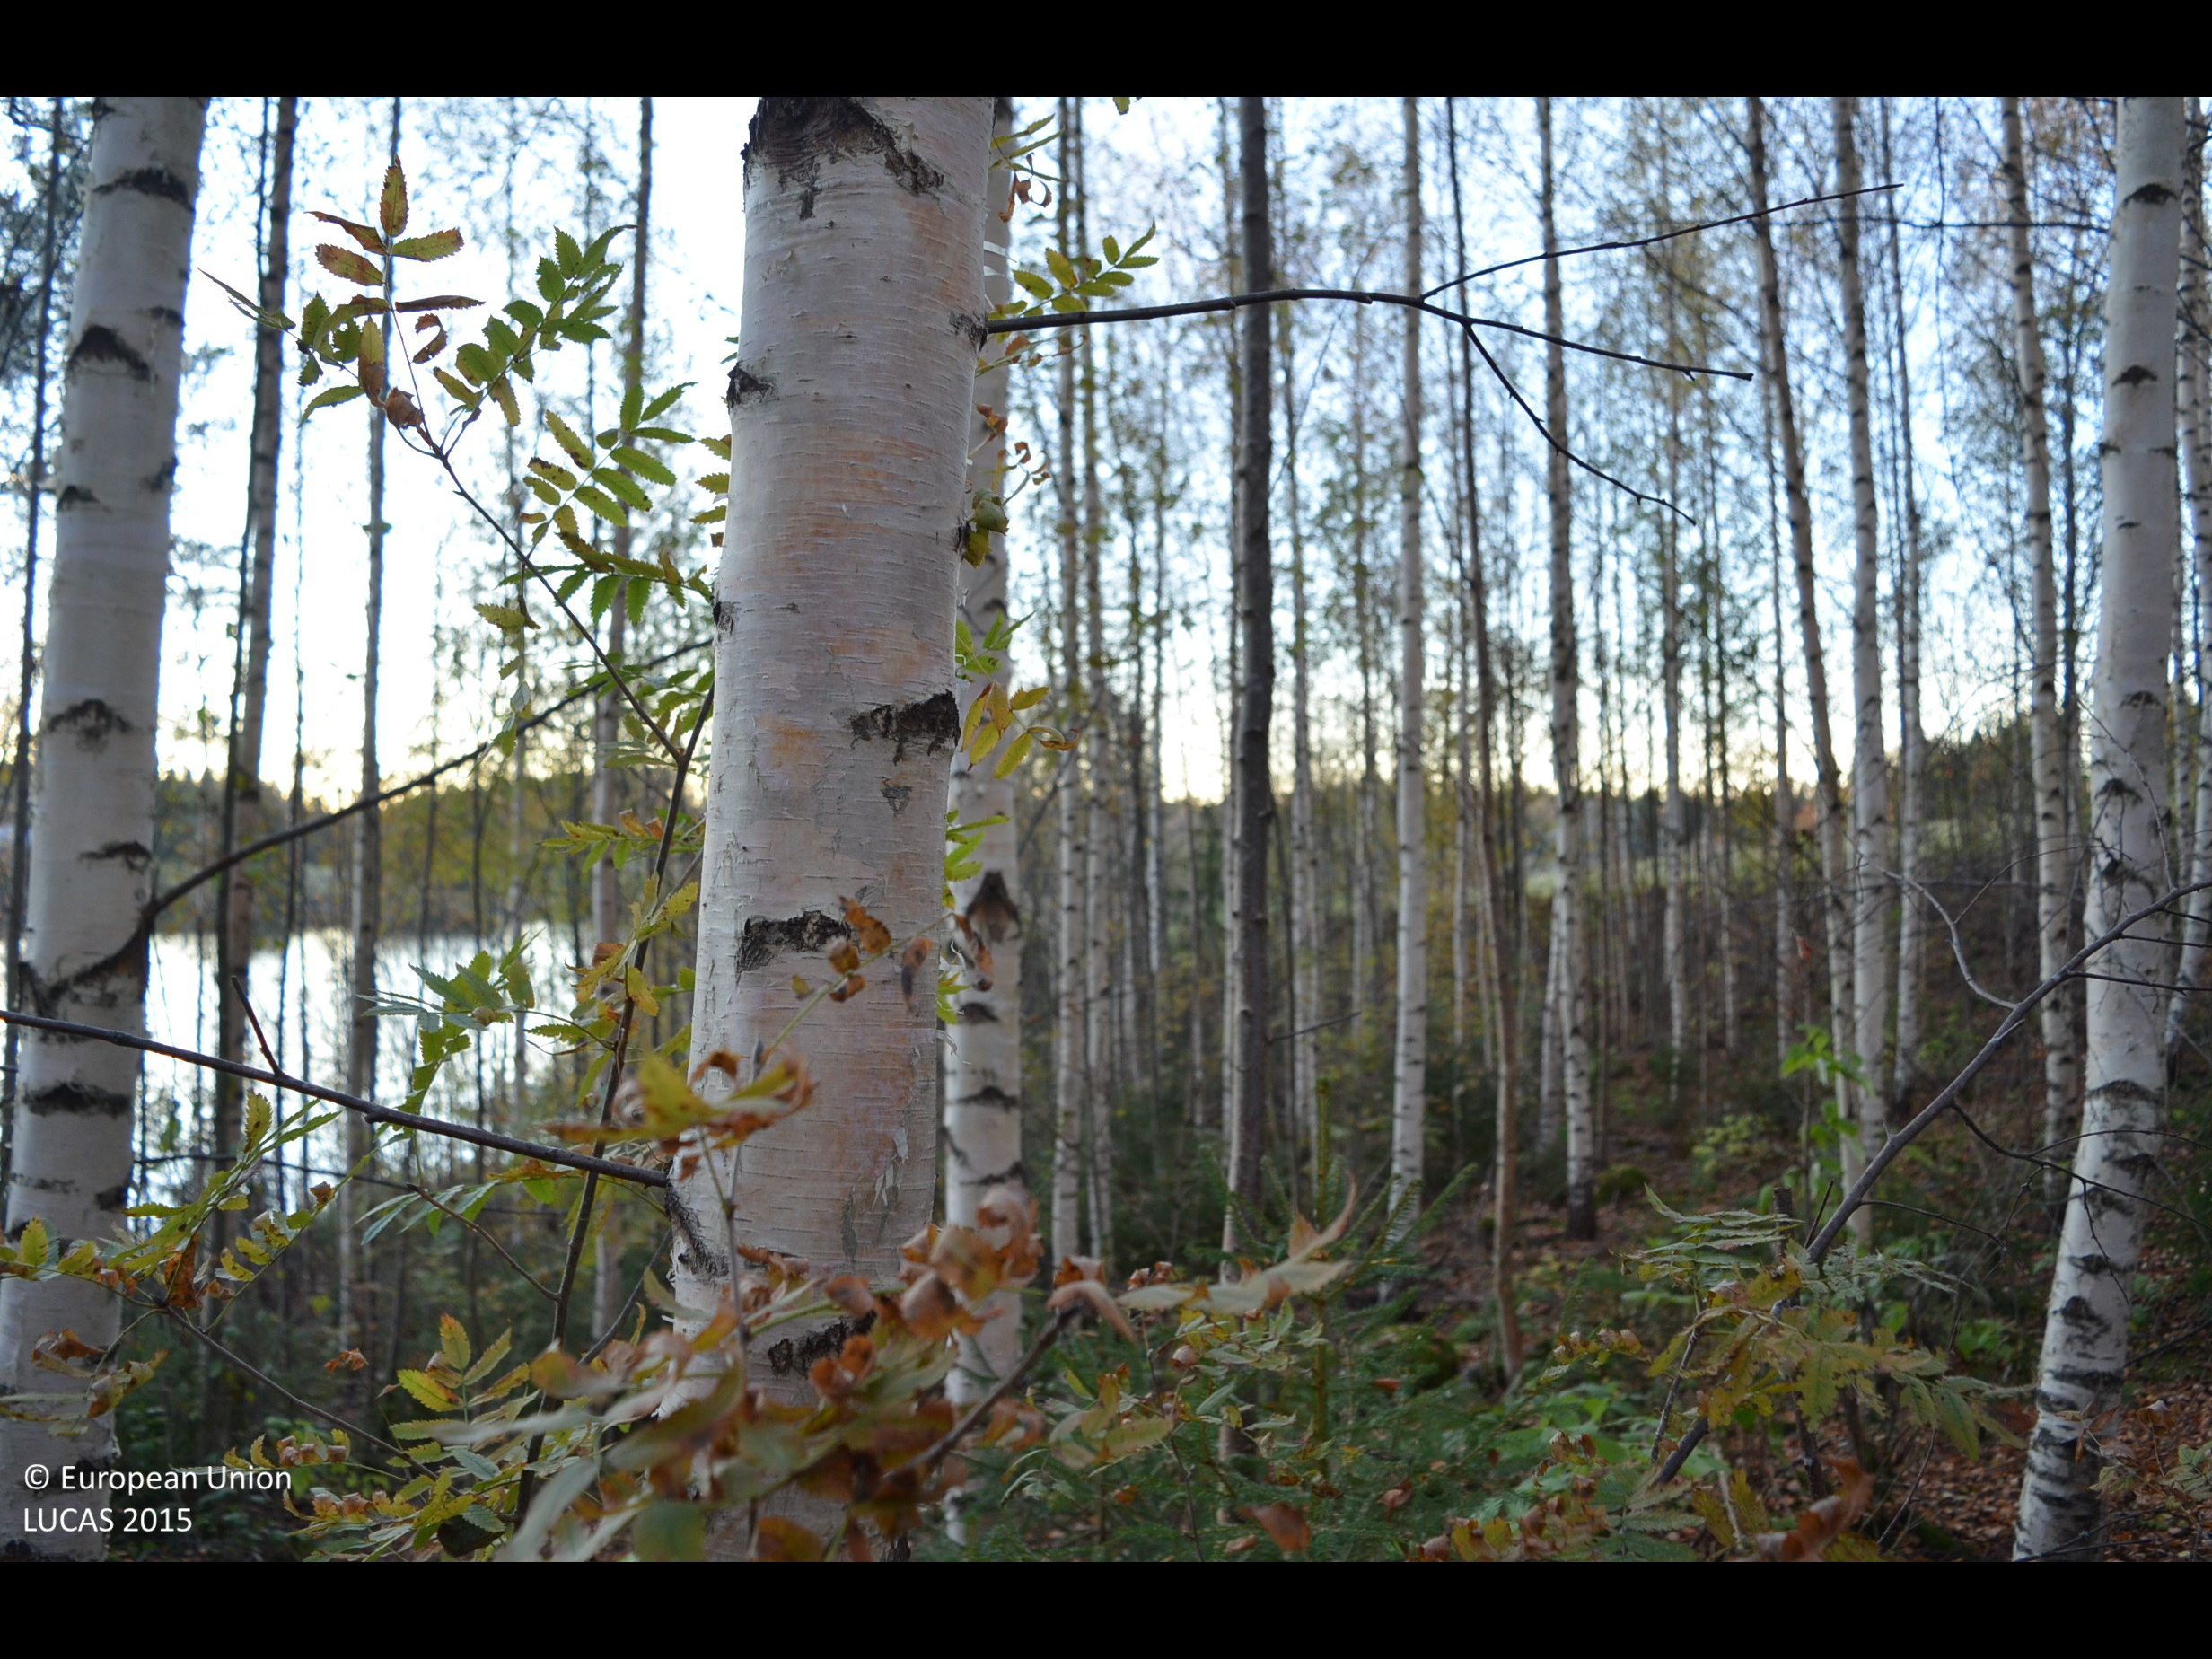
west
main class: Woodland
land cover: Broadleaved woodland
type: boreal forest
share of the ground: > 75 %
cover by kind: broadleaved forest trees 80 %, coniferous forest trees 5 %, shrubs 5 %
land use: Forestry
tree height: > 5 m
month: October
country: FI
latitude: 61.8287
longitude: 23.9649
